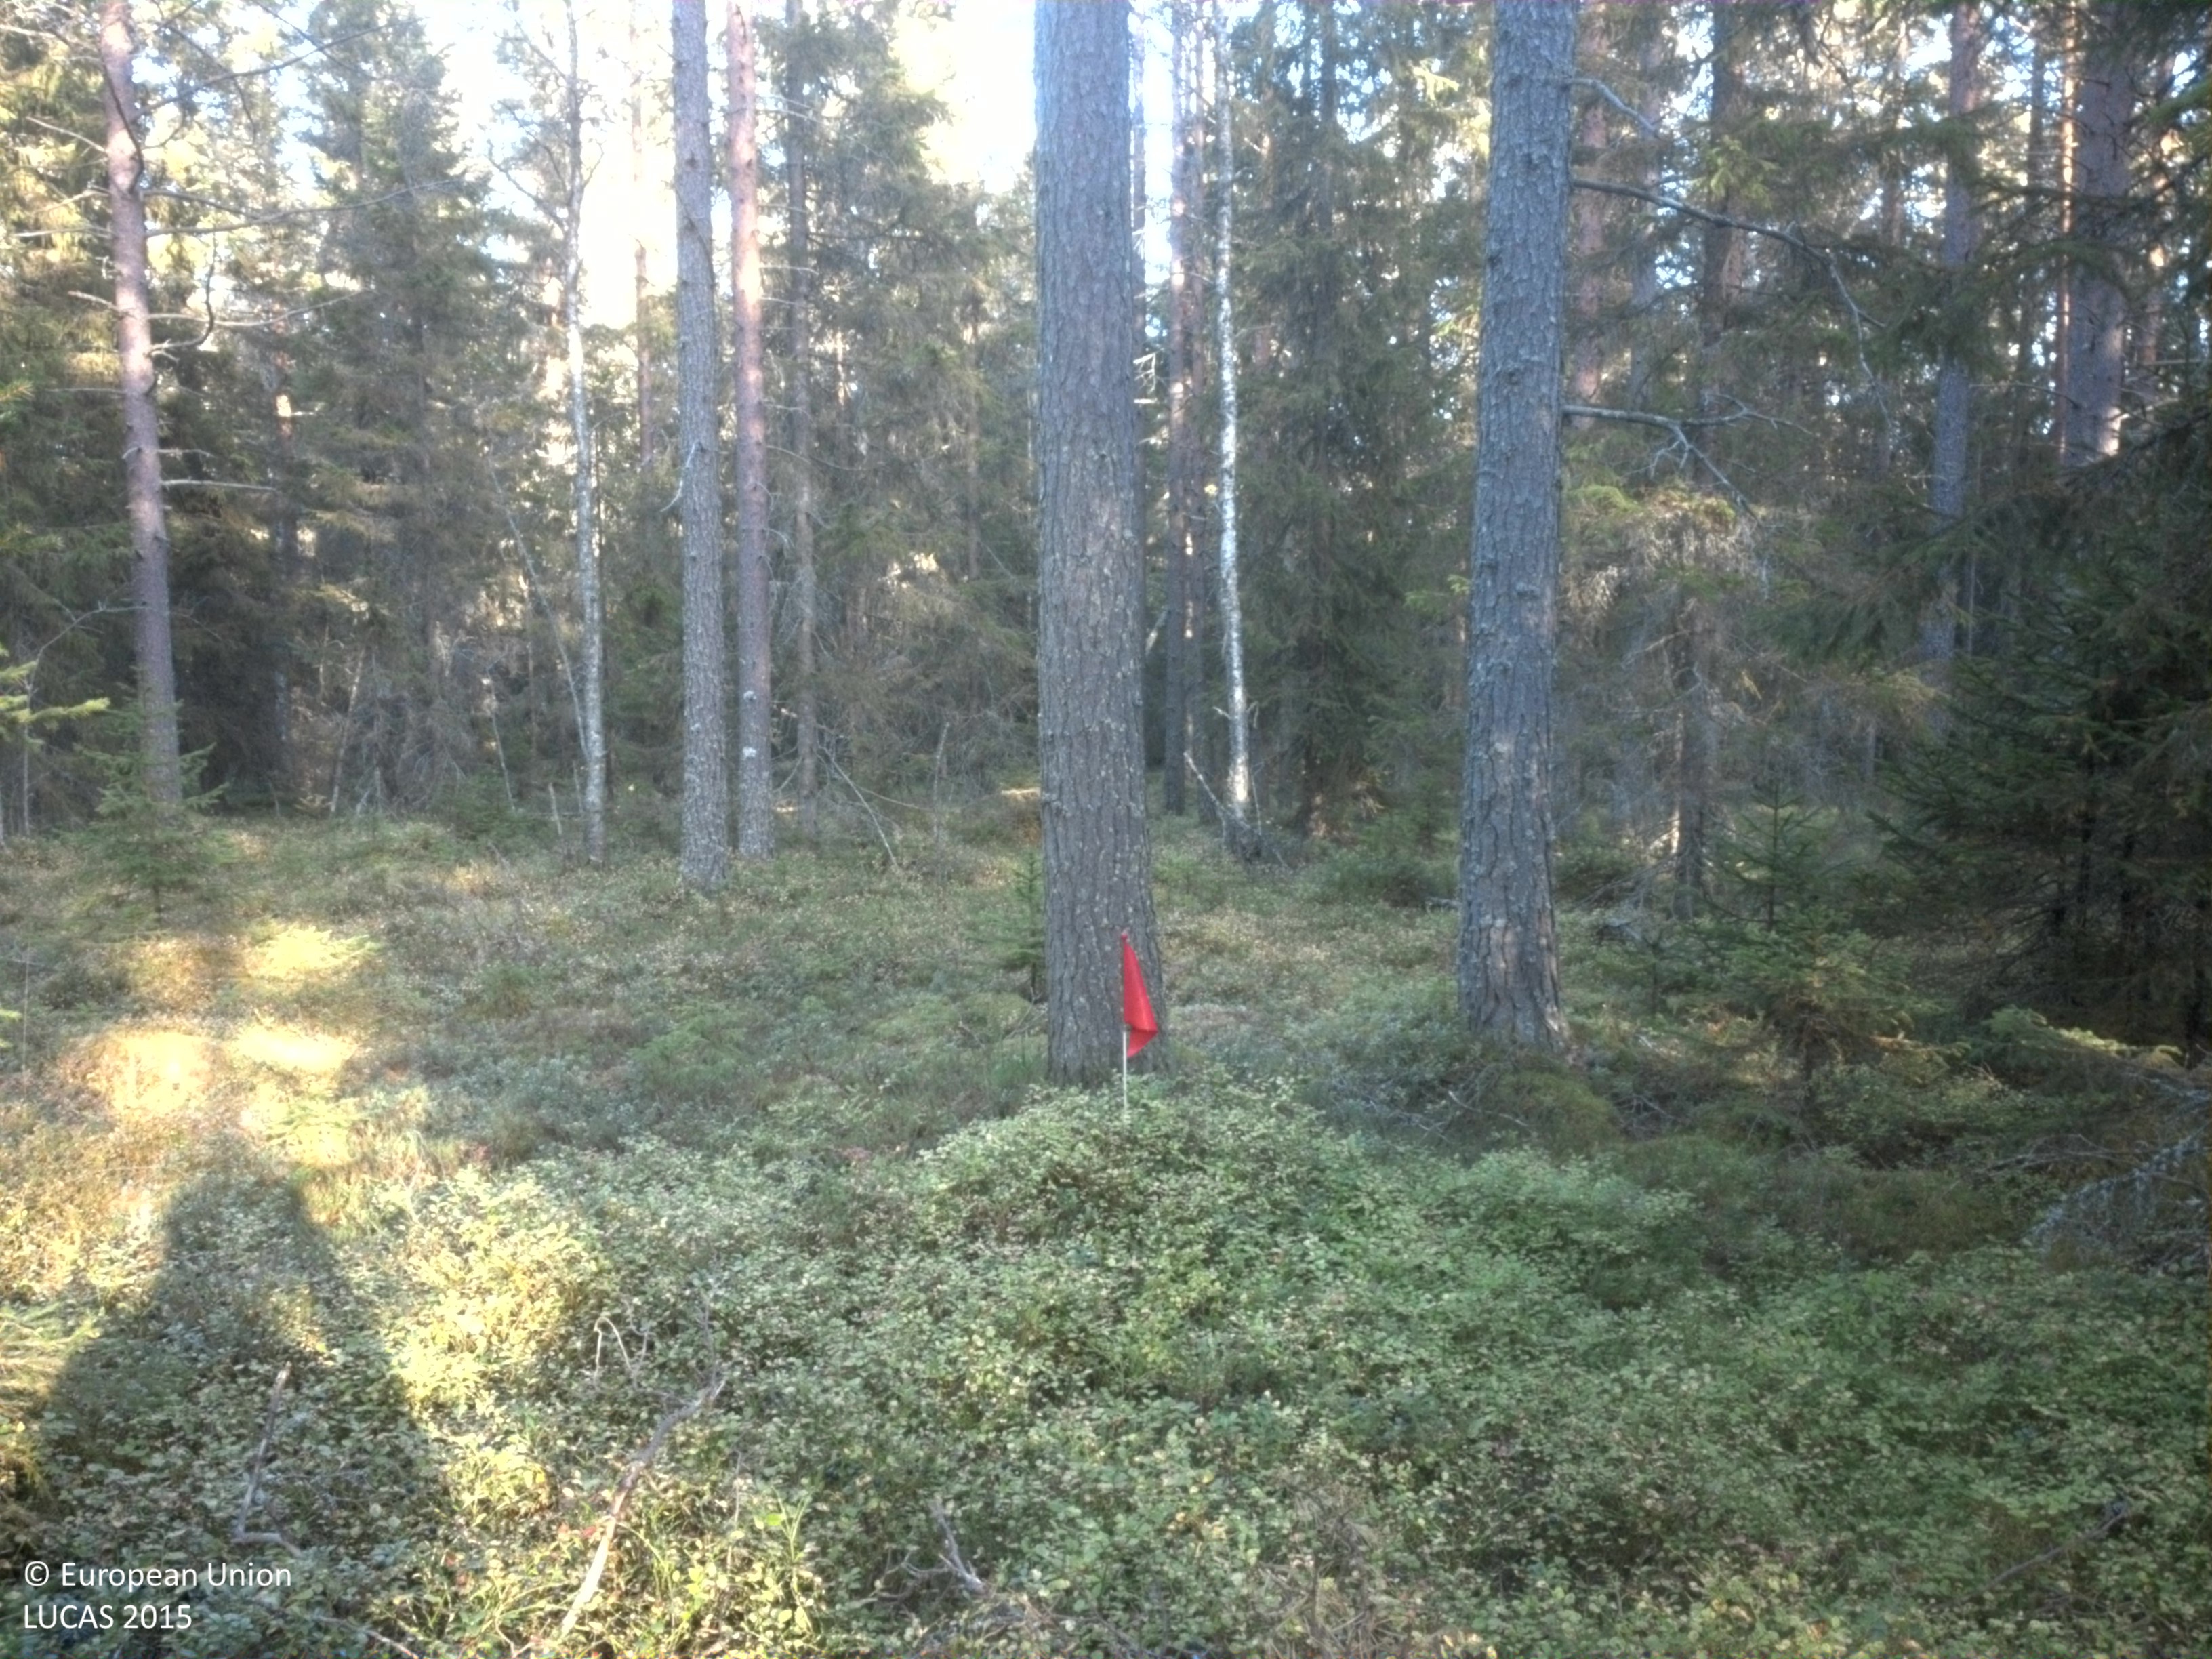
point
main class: Woodland
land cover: Other coniferous woodland
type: boreal forest
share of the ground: 50 - 75 %
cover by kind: coniferous forest trees 65 %, shrubs 30 %, lichens and mosses 5 %
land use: Forestry
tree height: > 5 m
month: October
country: SE
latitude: 63.8707
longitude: 20.7101
